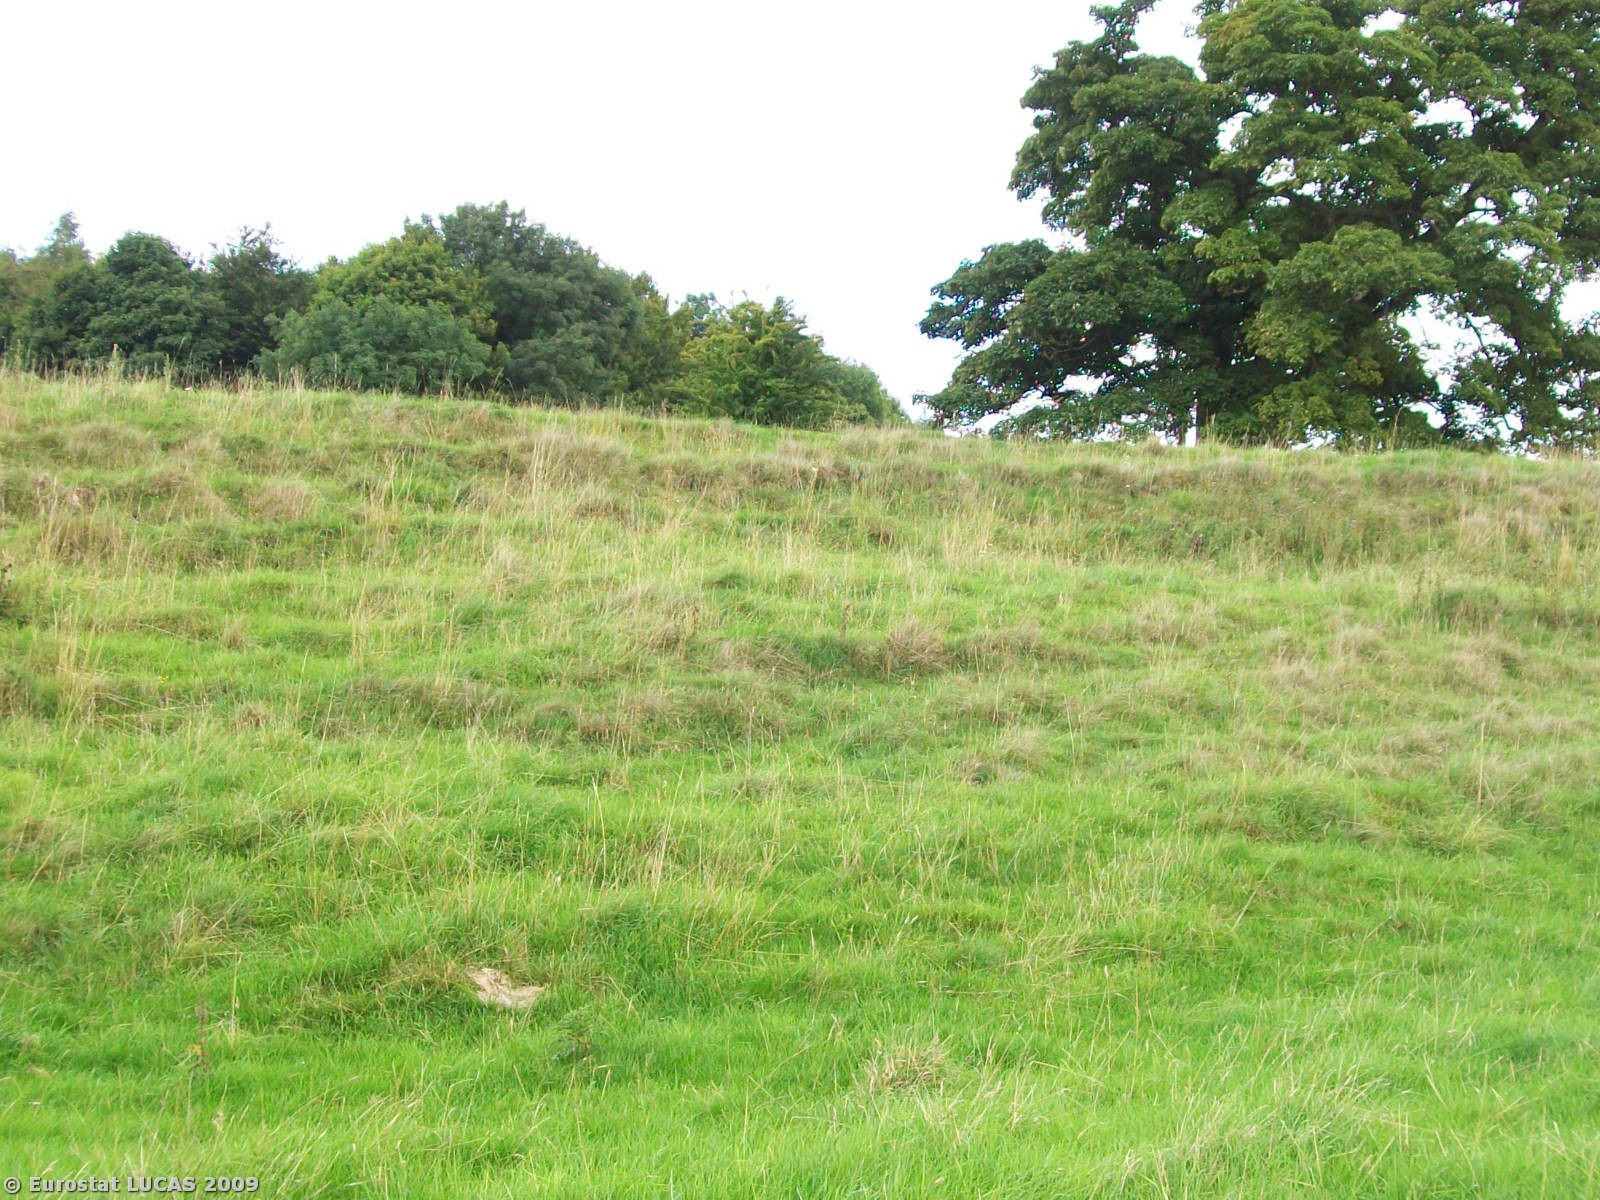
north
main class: Grassland
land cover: Grassland without tree/shrub cover
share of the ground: > 75 %
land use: Agriculture (excluding fallow land and kitchen gardens)
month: August
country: GB
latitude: 51.6672
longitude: -2.2510
